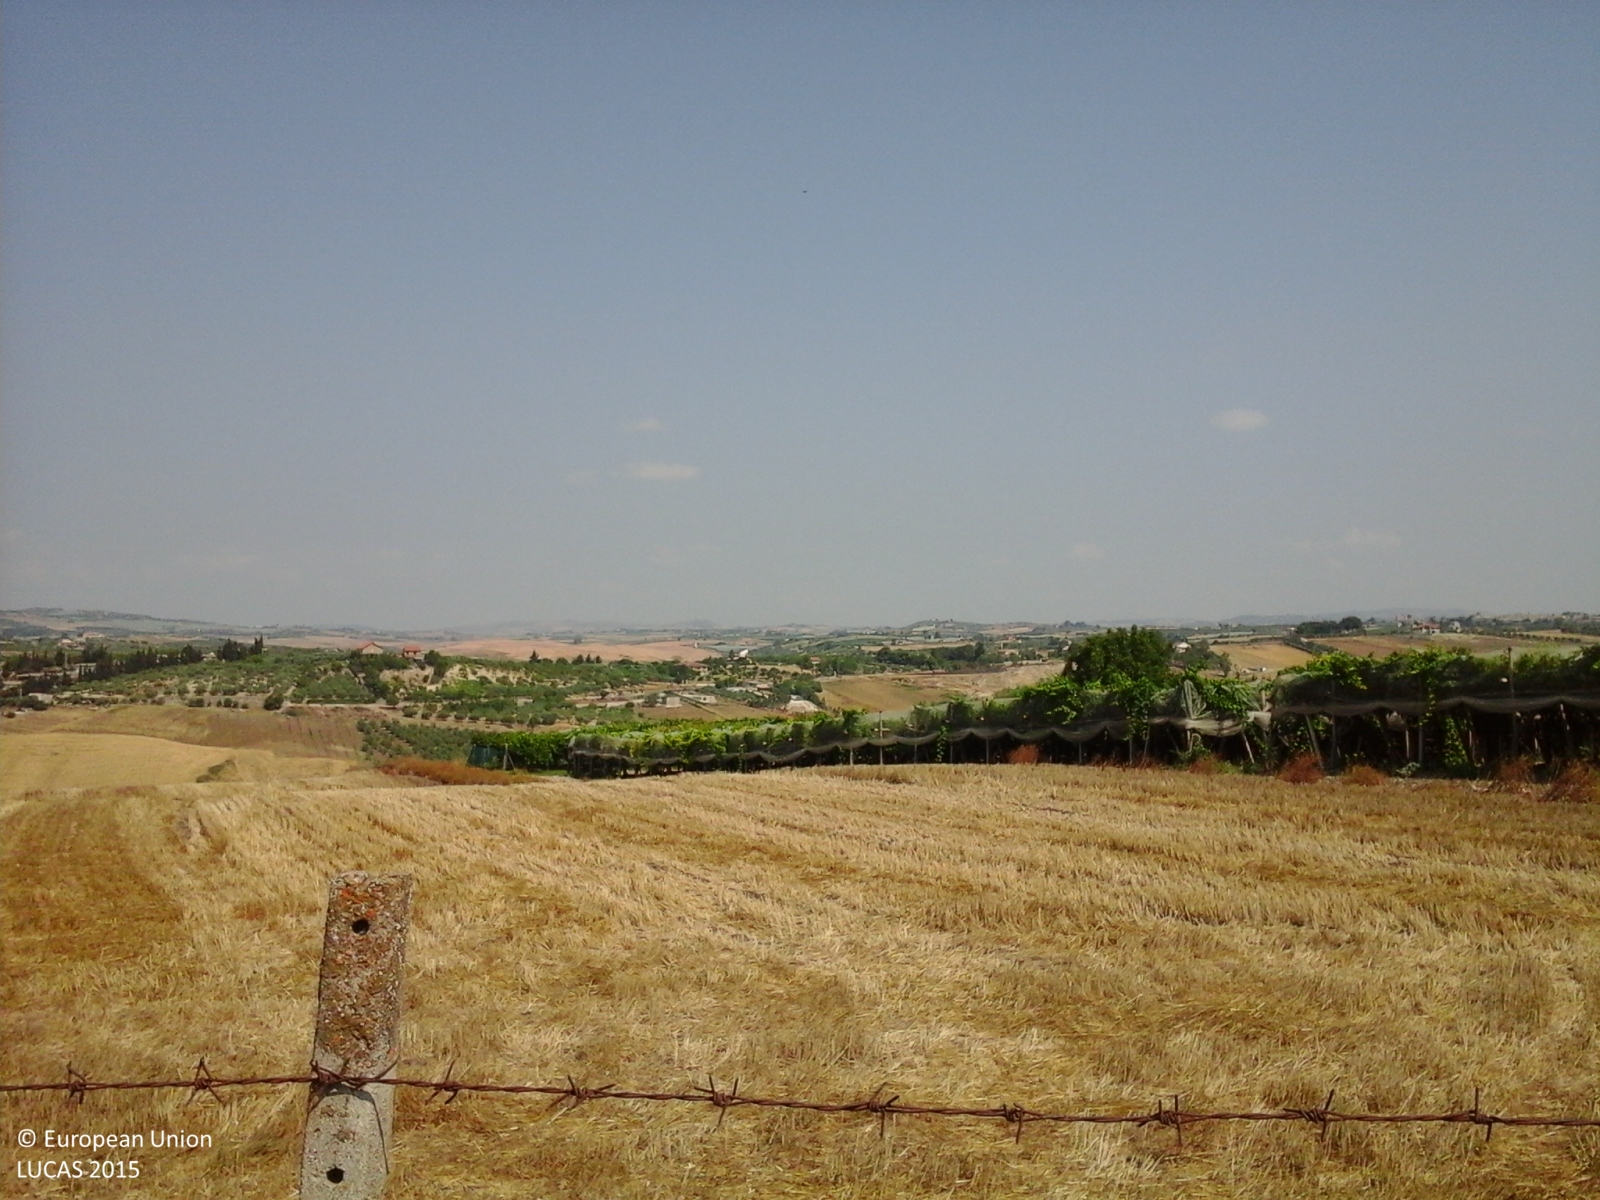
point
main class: Cropland
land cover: Vineyards
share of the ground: > 75 %
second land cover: Other bare soil
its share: > 75 %
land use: Agriculture (excluding fallow land and kitchen gardens)
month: July
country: IT
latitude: 37.2493
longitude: 13.9042
